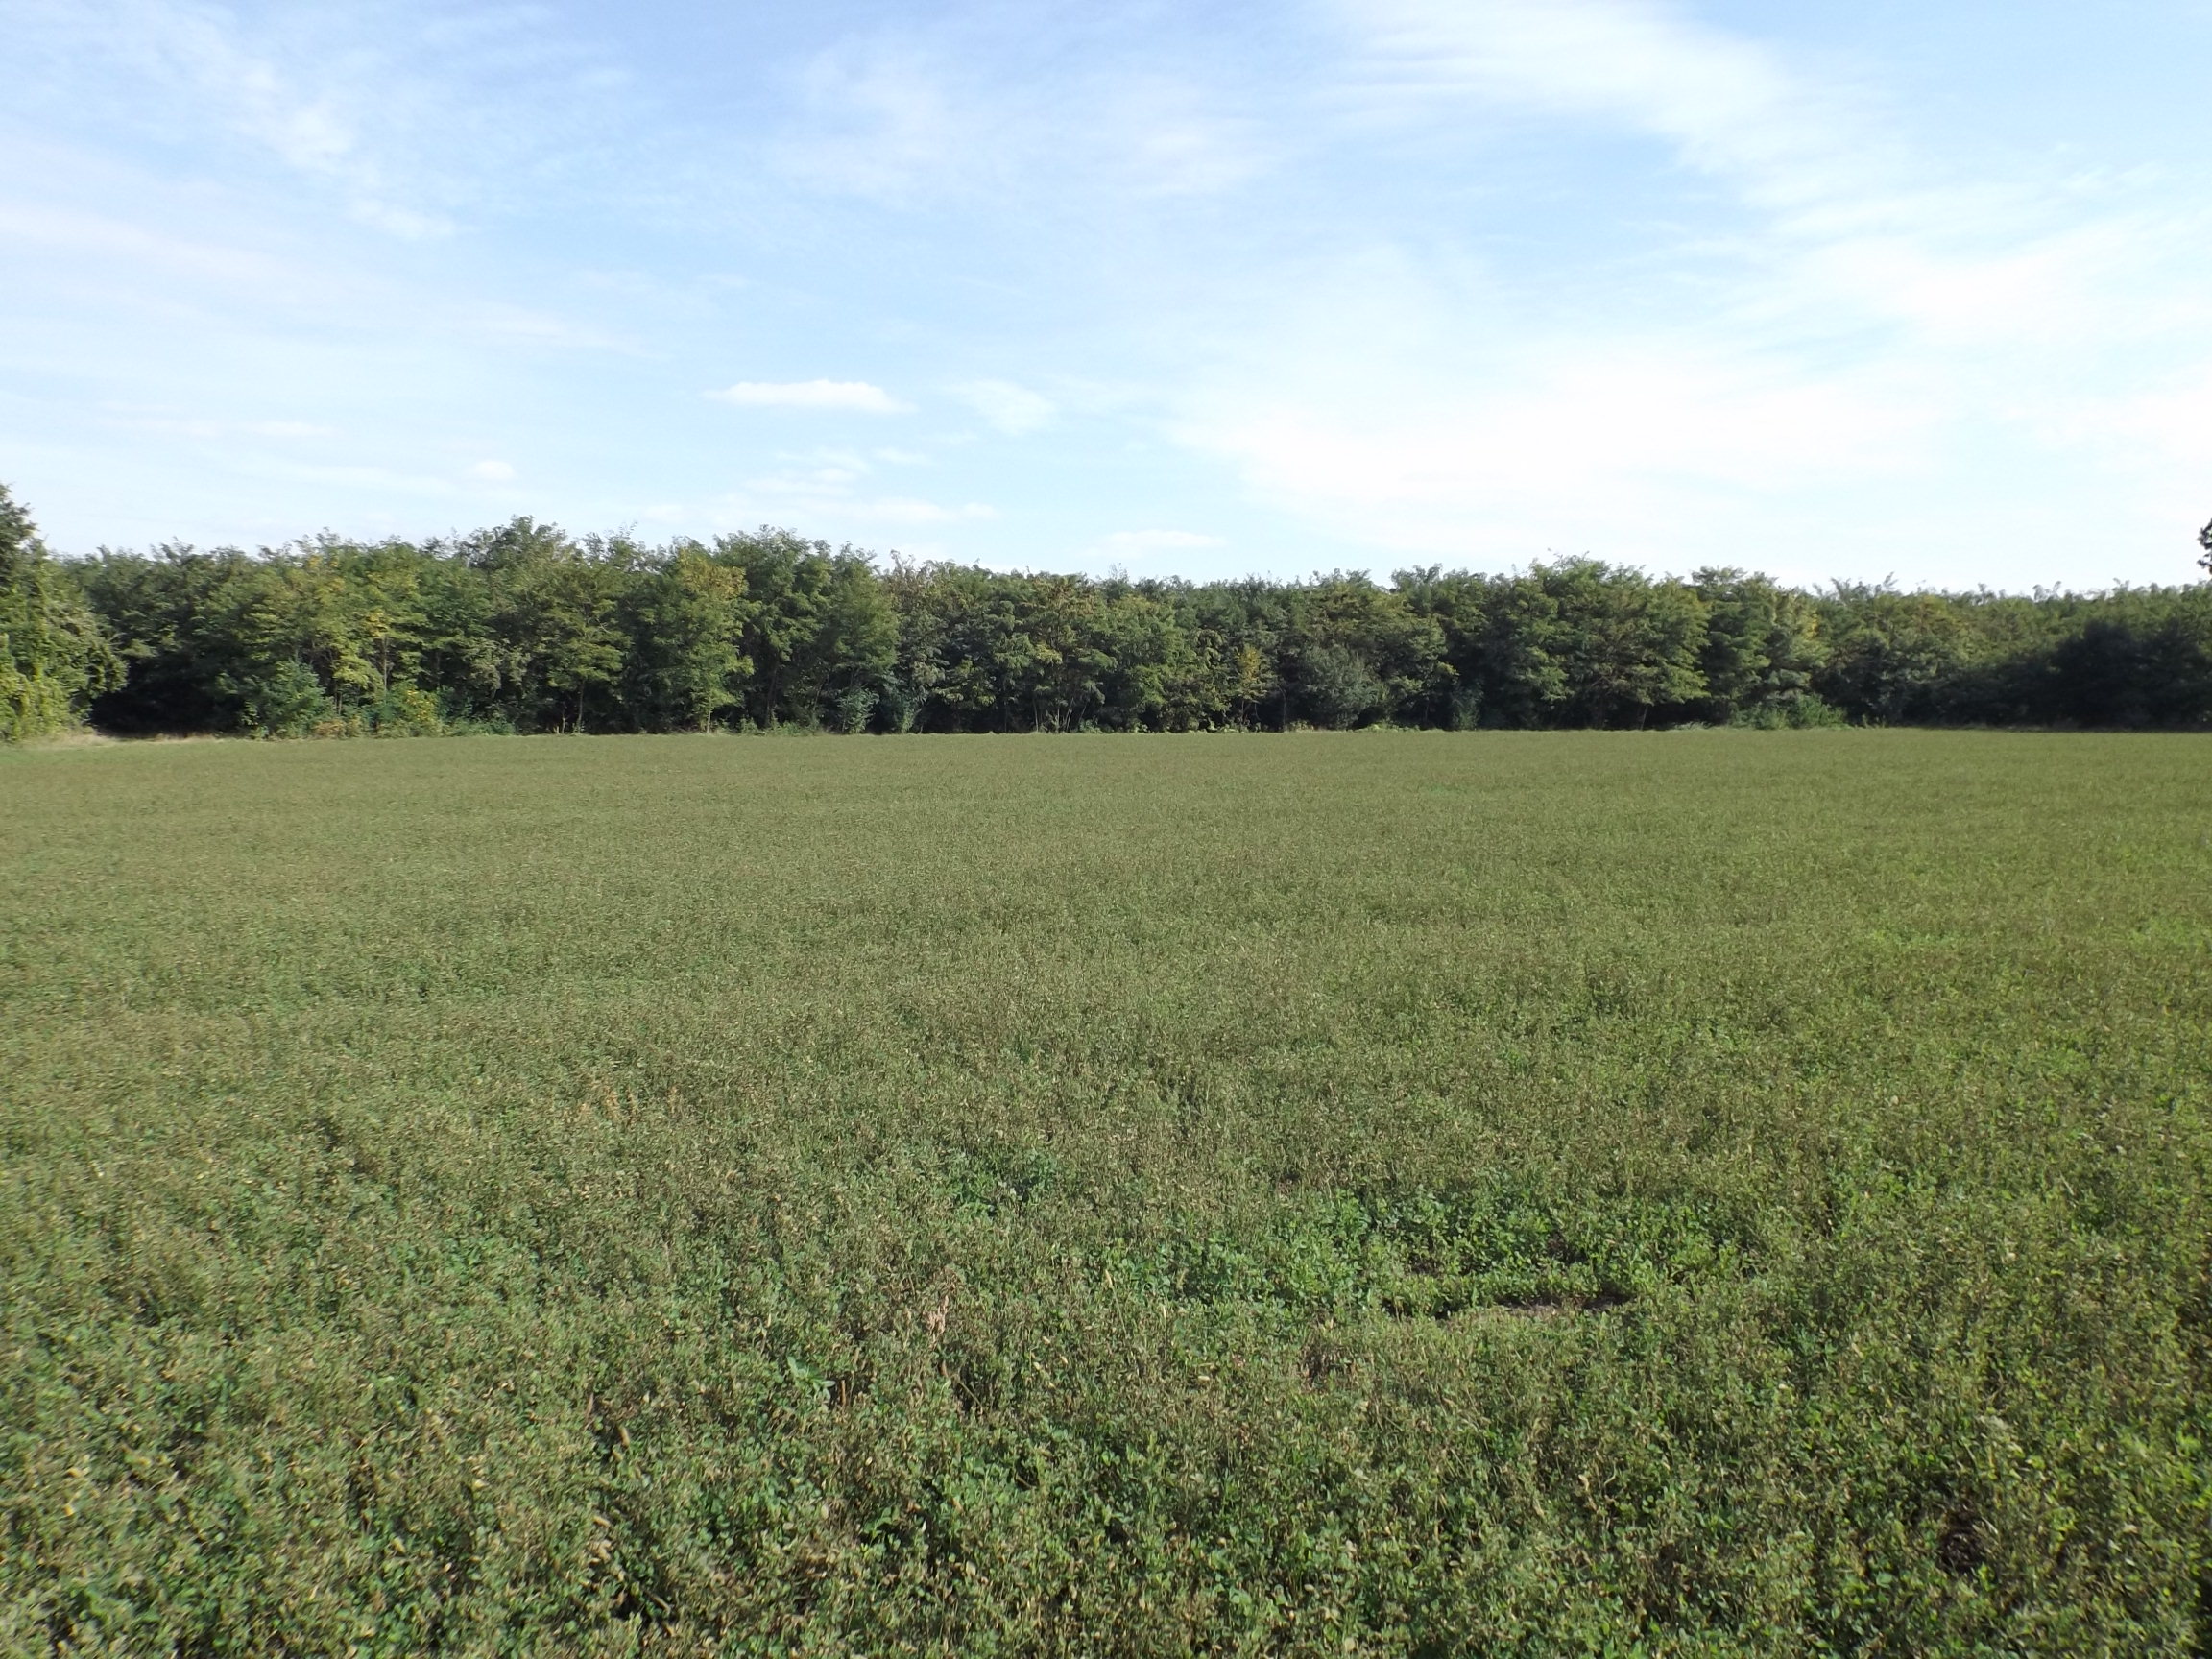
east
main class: Cropland
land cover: Lucerne
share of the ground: > 75 %
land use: Agriculture (excluding fallow land and kitchen gardens)
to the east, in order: Lucerne; Grass margins; Broadleaved woodland
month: October
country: BG
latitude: 43.8736
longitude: 26.7792
